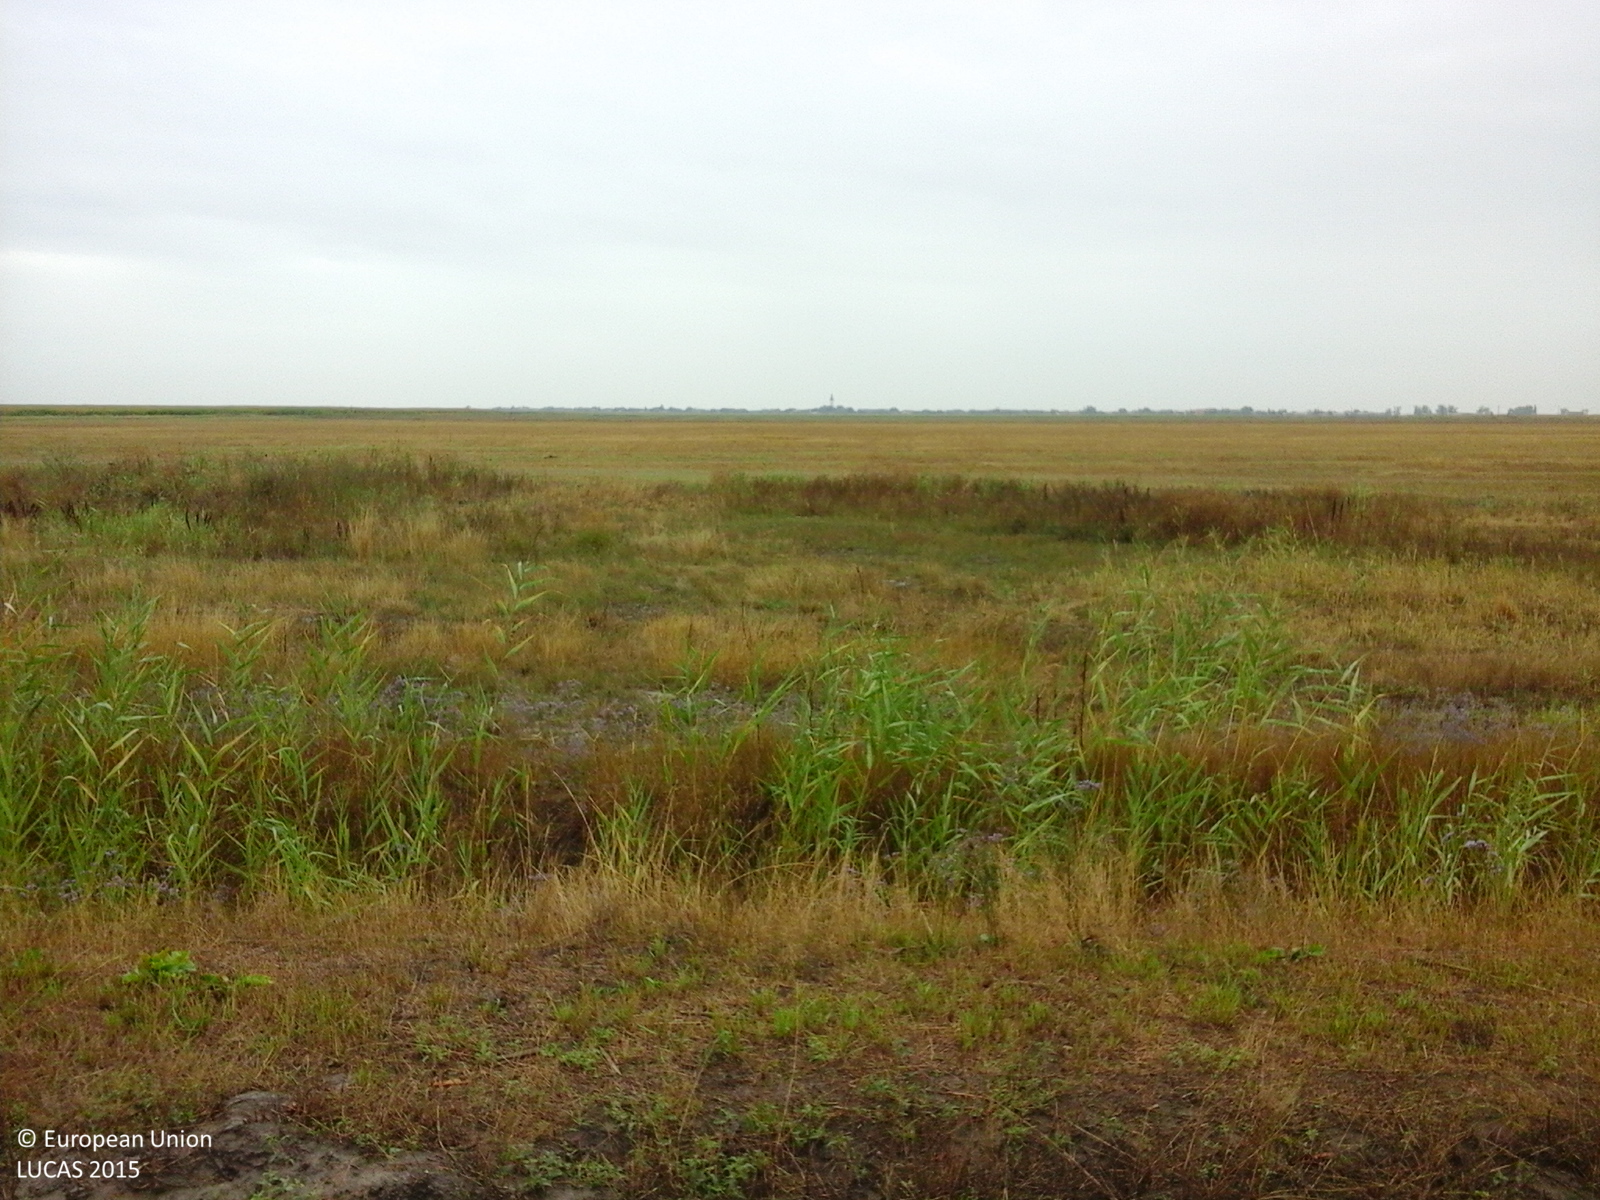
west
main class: Cropland
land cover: Common wheat
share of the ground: < 10 %
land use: Agriculture (excluding fallow land and kitchen gardens)
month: August
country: RO
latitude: 45.6015
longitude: 20.9888
